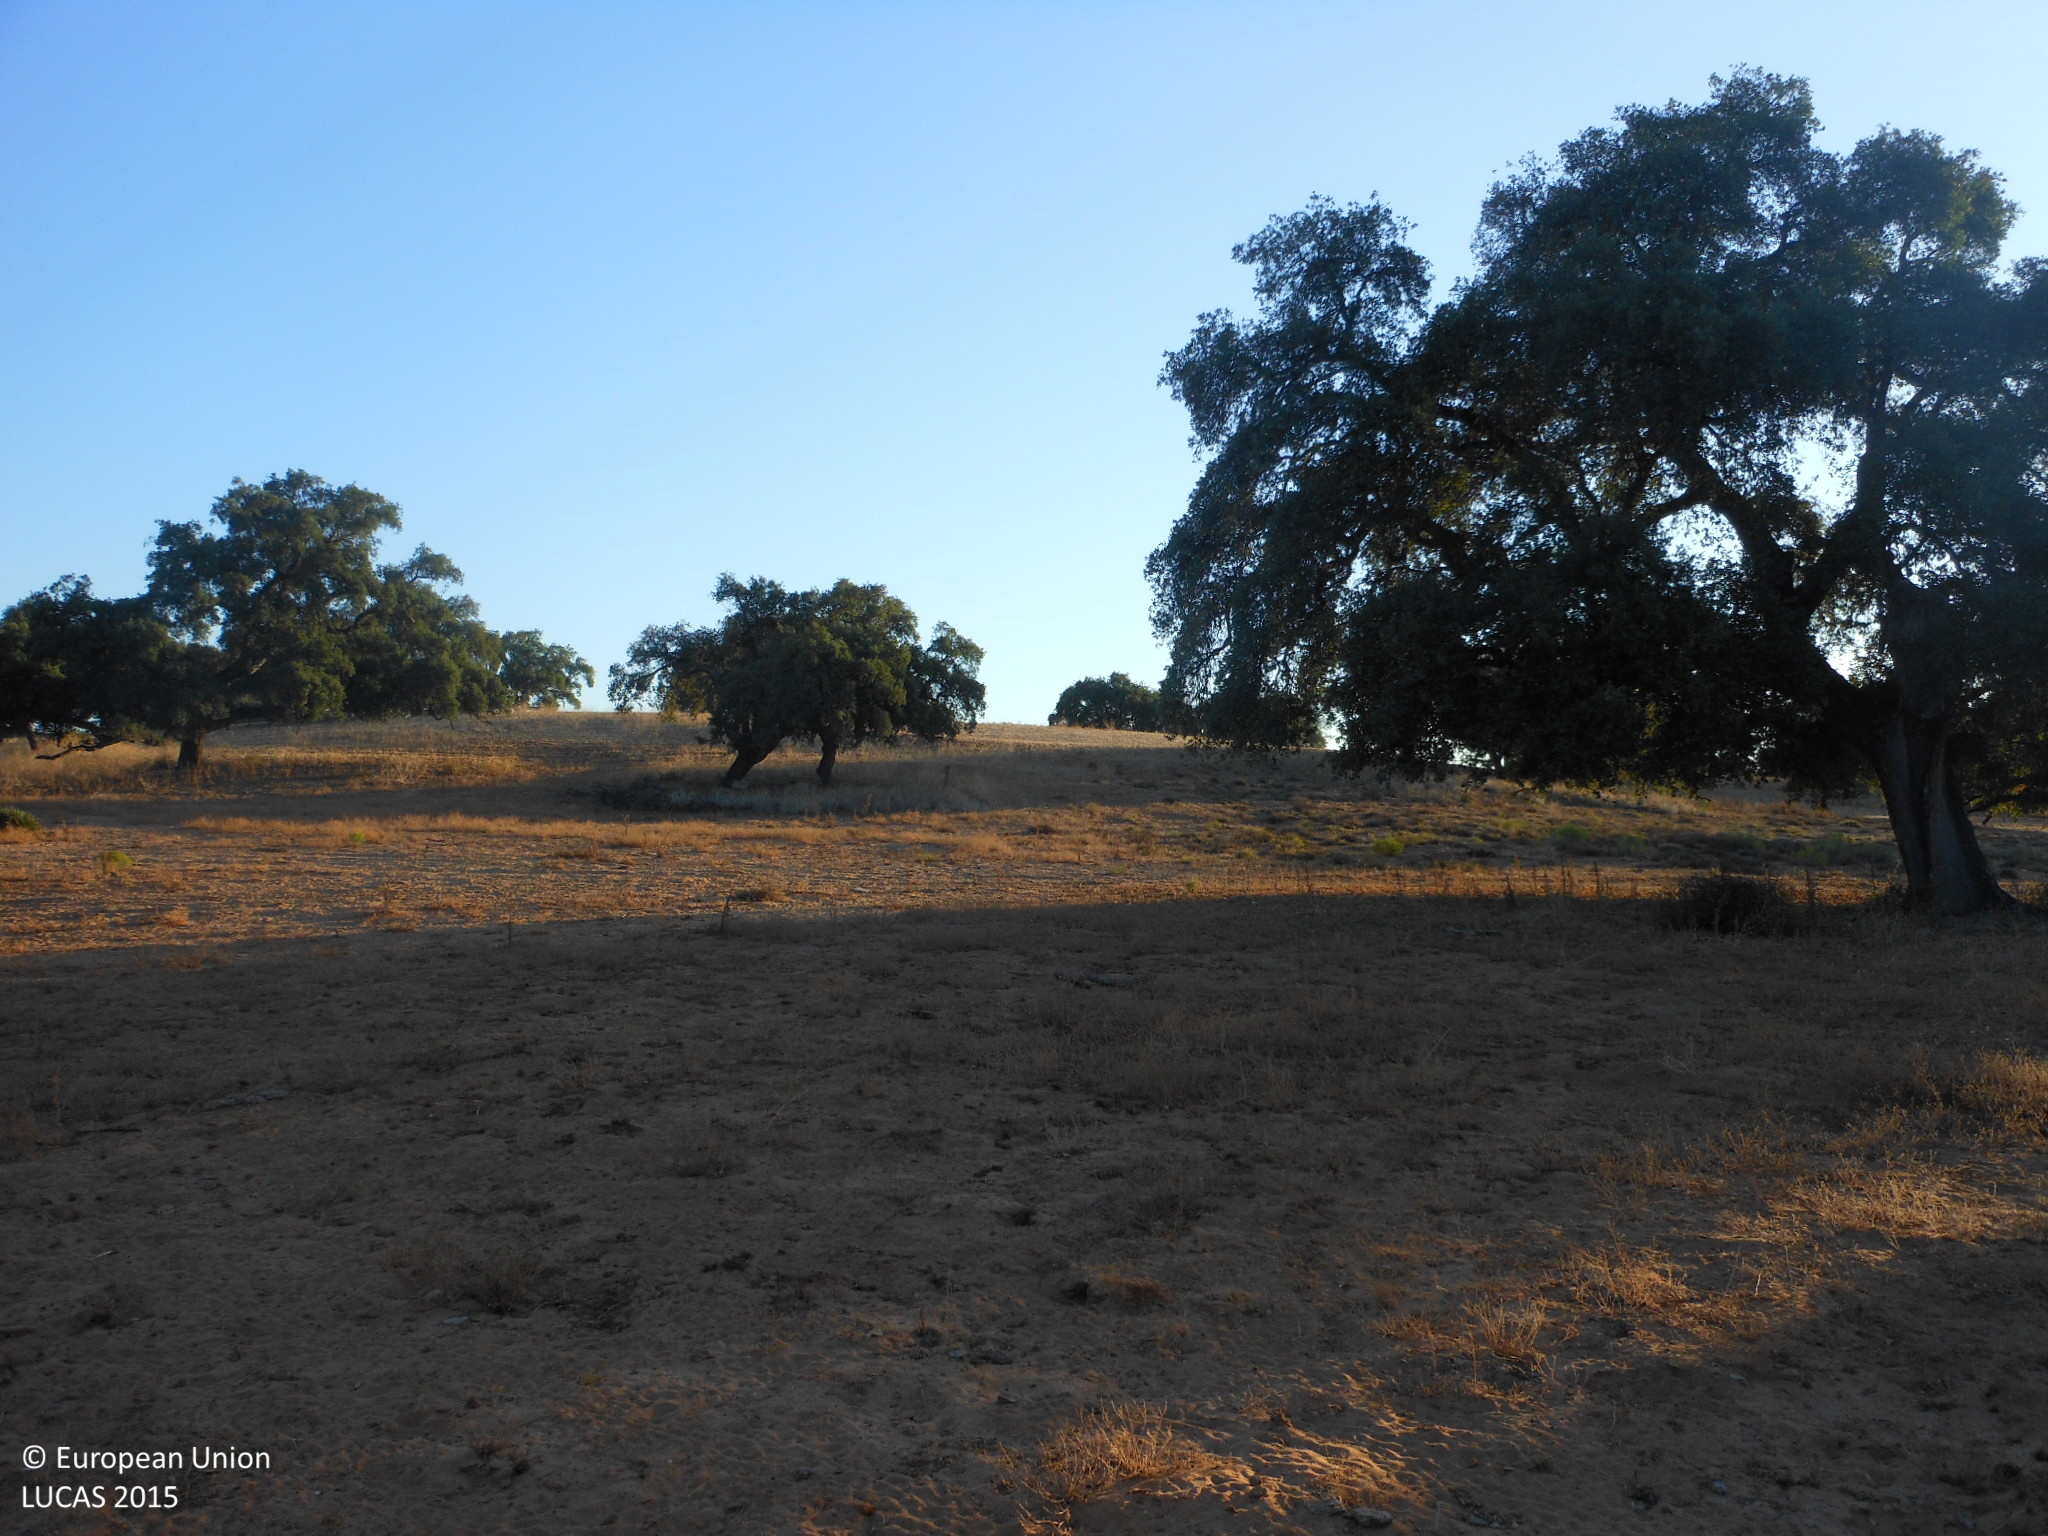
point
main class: Woodland
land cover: Broadleaved woodland
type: broadleaved evergreen forest
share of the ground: 50 - 75 %
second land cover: Shrubland without tree cover
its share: 10 - 25 %
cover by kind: broadleaved forest trees 60 %, unconsolidated bare surface 20 %, shrubs 15 %, herbaceous plants 5 %
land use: Forestry
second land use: Agriculture (excluding fallow land and kitchen gardens)
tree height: > 5 m
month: July
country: ES
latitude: 37.2649
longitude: -5.4730
